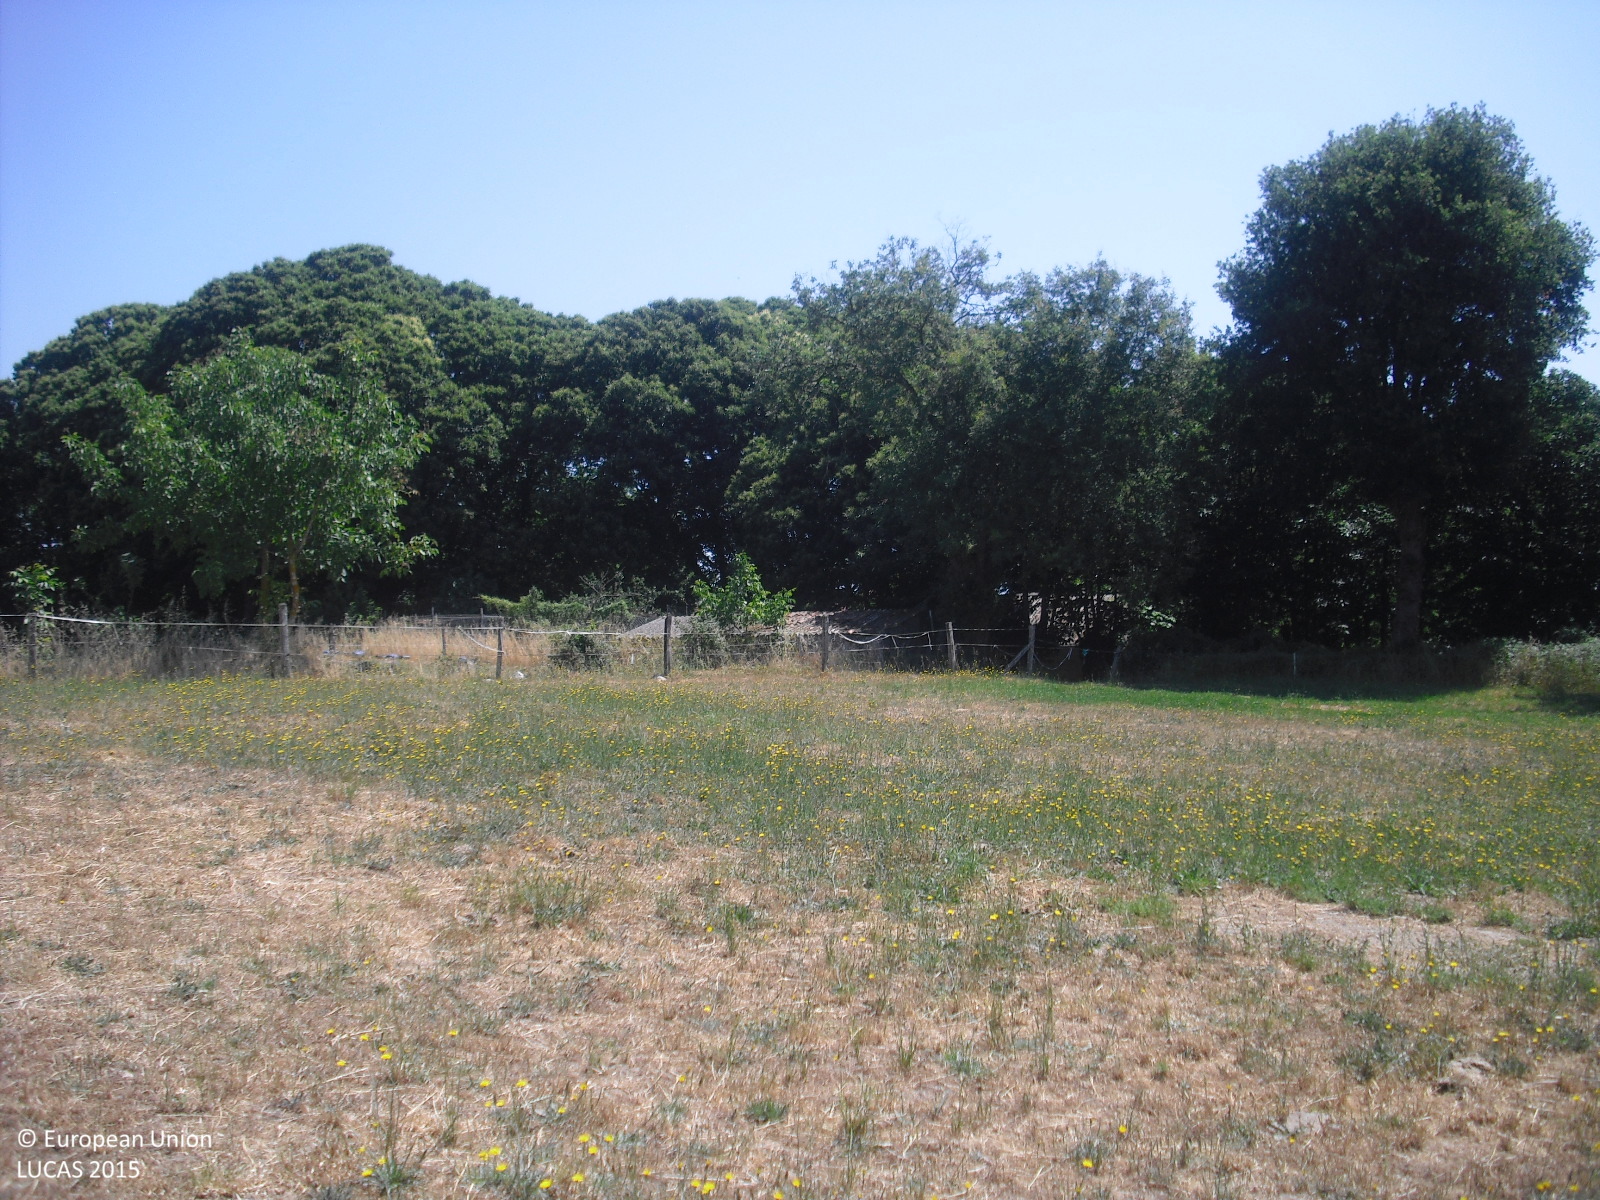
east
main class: Cropland
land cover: Temporary grasslands
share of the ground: > 75 %
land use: Agriculture (excluding fallow land and kitchen gardens)
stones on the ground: 25 - 50 %
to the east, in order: Temporary grasslands; Shruby margins; Dry stone walls; Shruby margins; Nuts trees; Dry stone walls; Tracks; Nuts trees; Artificial constructions in urban areas; Dry stone walls; Grassland with sparse tree/shrub cover; Dry stone walls; Artificial constructions in urban areas
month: June
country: ES
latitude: 42.6176
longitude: -7.7678
